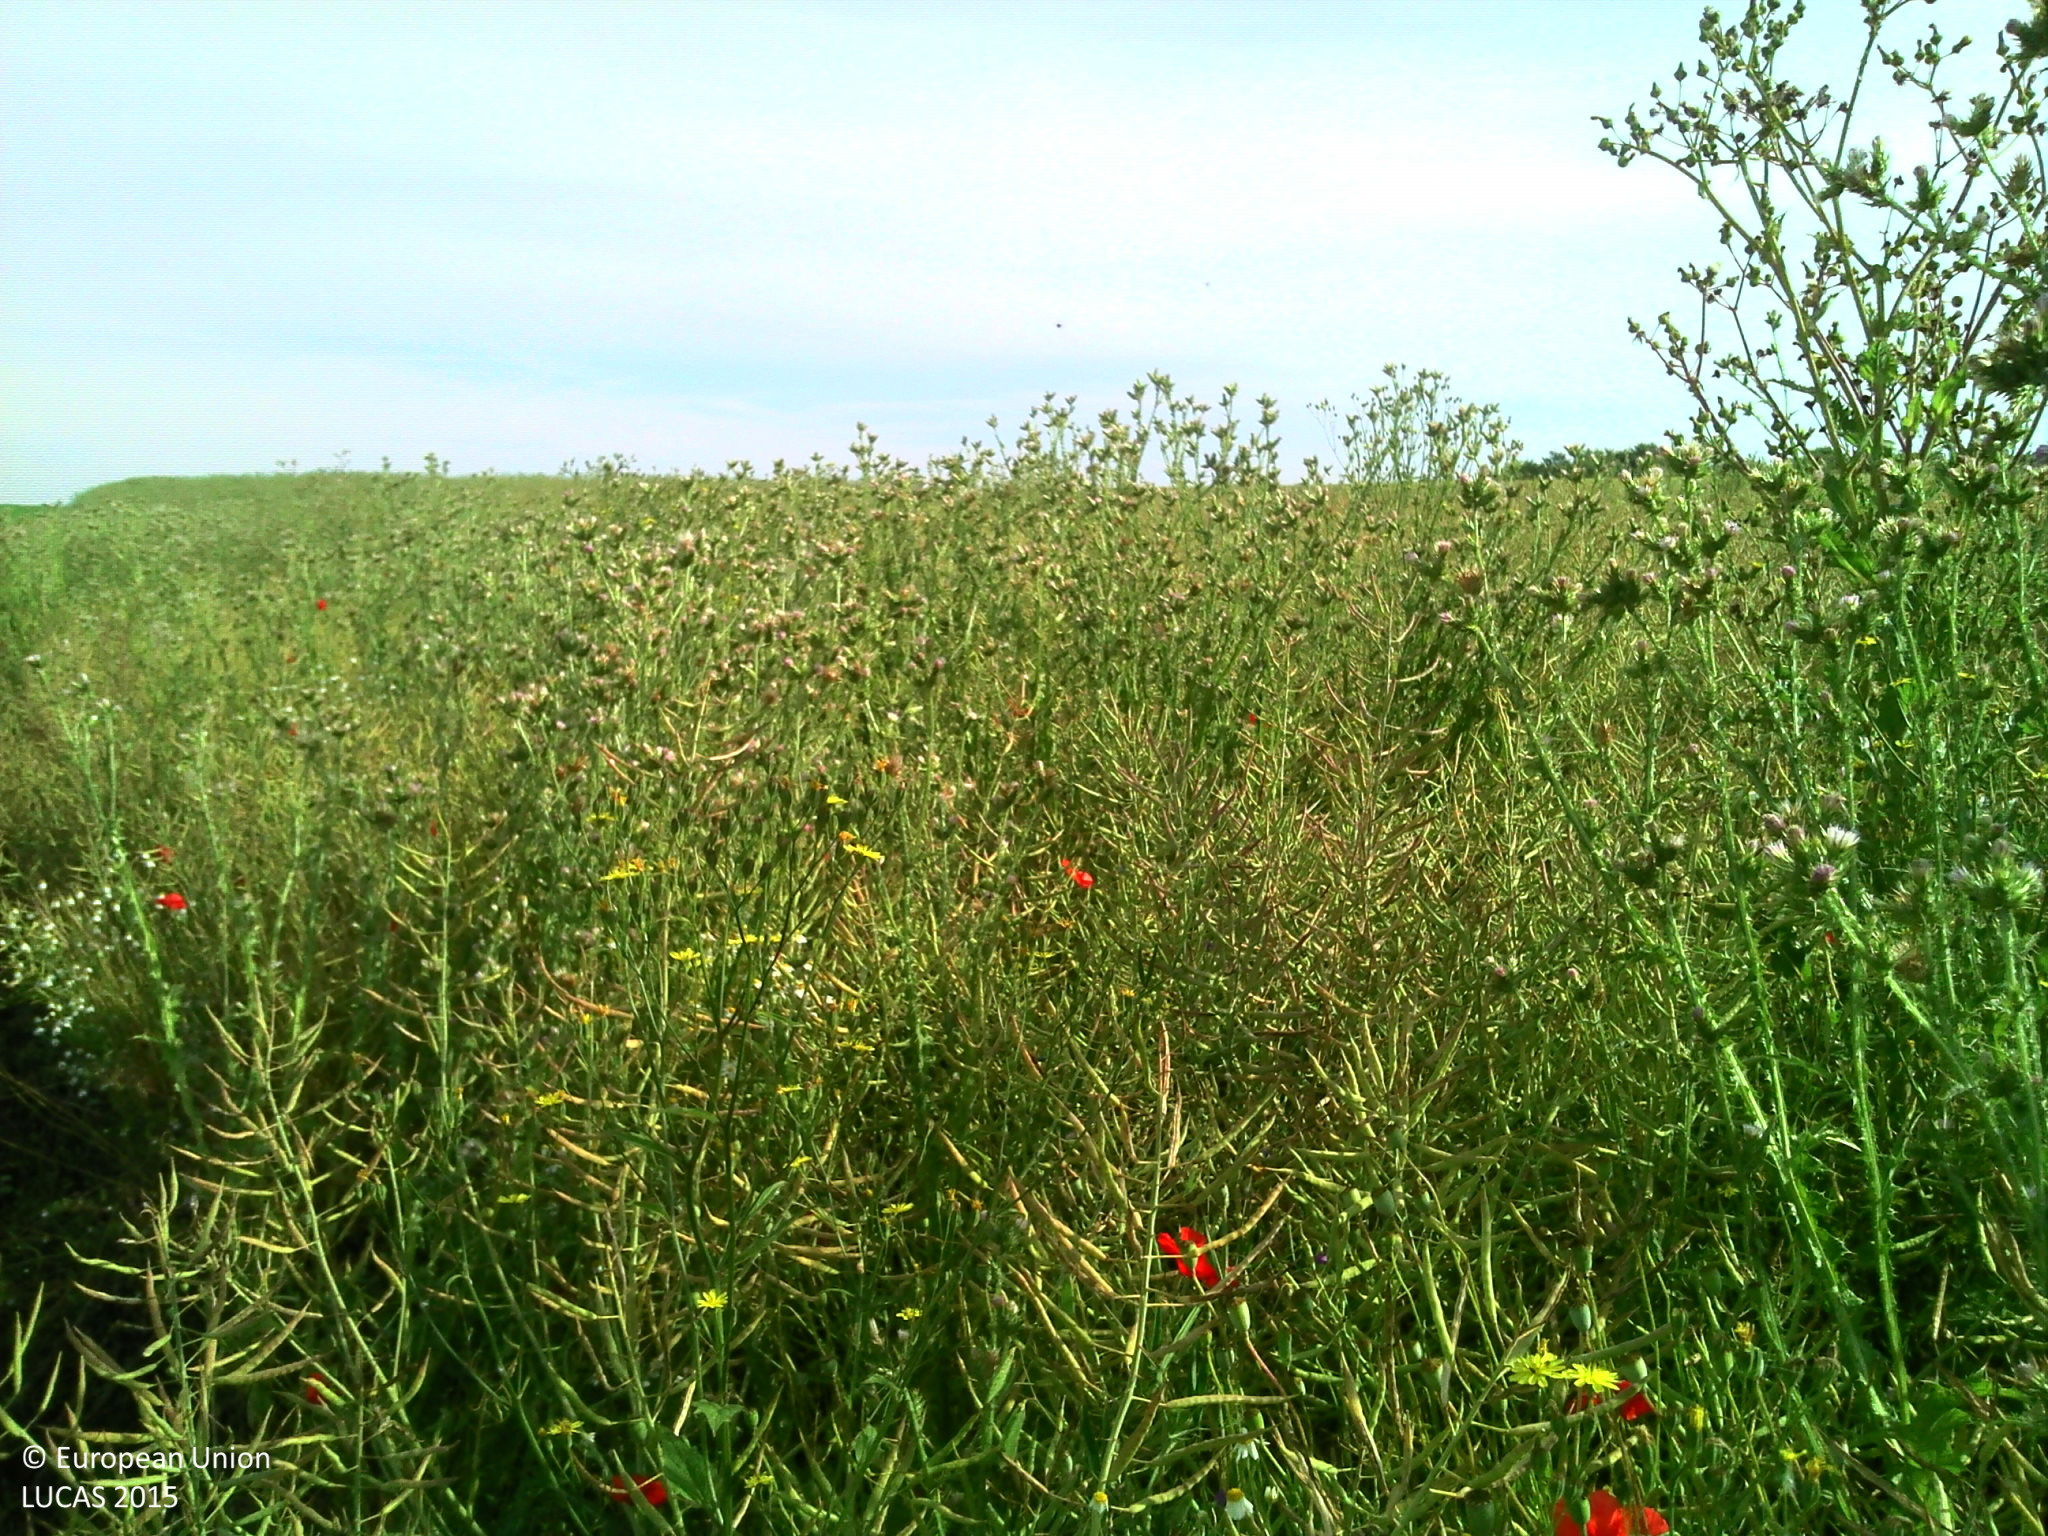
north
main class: Cropland
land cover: Rape and turnip rape
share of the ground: 50 - 75 %
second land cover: Spontaneously vegetated surfaces
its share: 25 - 50 %
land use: Agriculture (excluding fallow land and kitchen gardens)
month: June
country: FR
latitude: 48.5680
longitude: 5.1606
